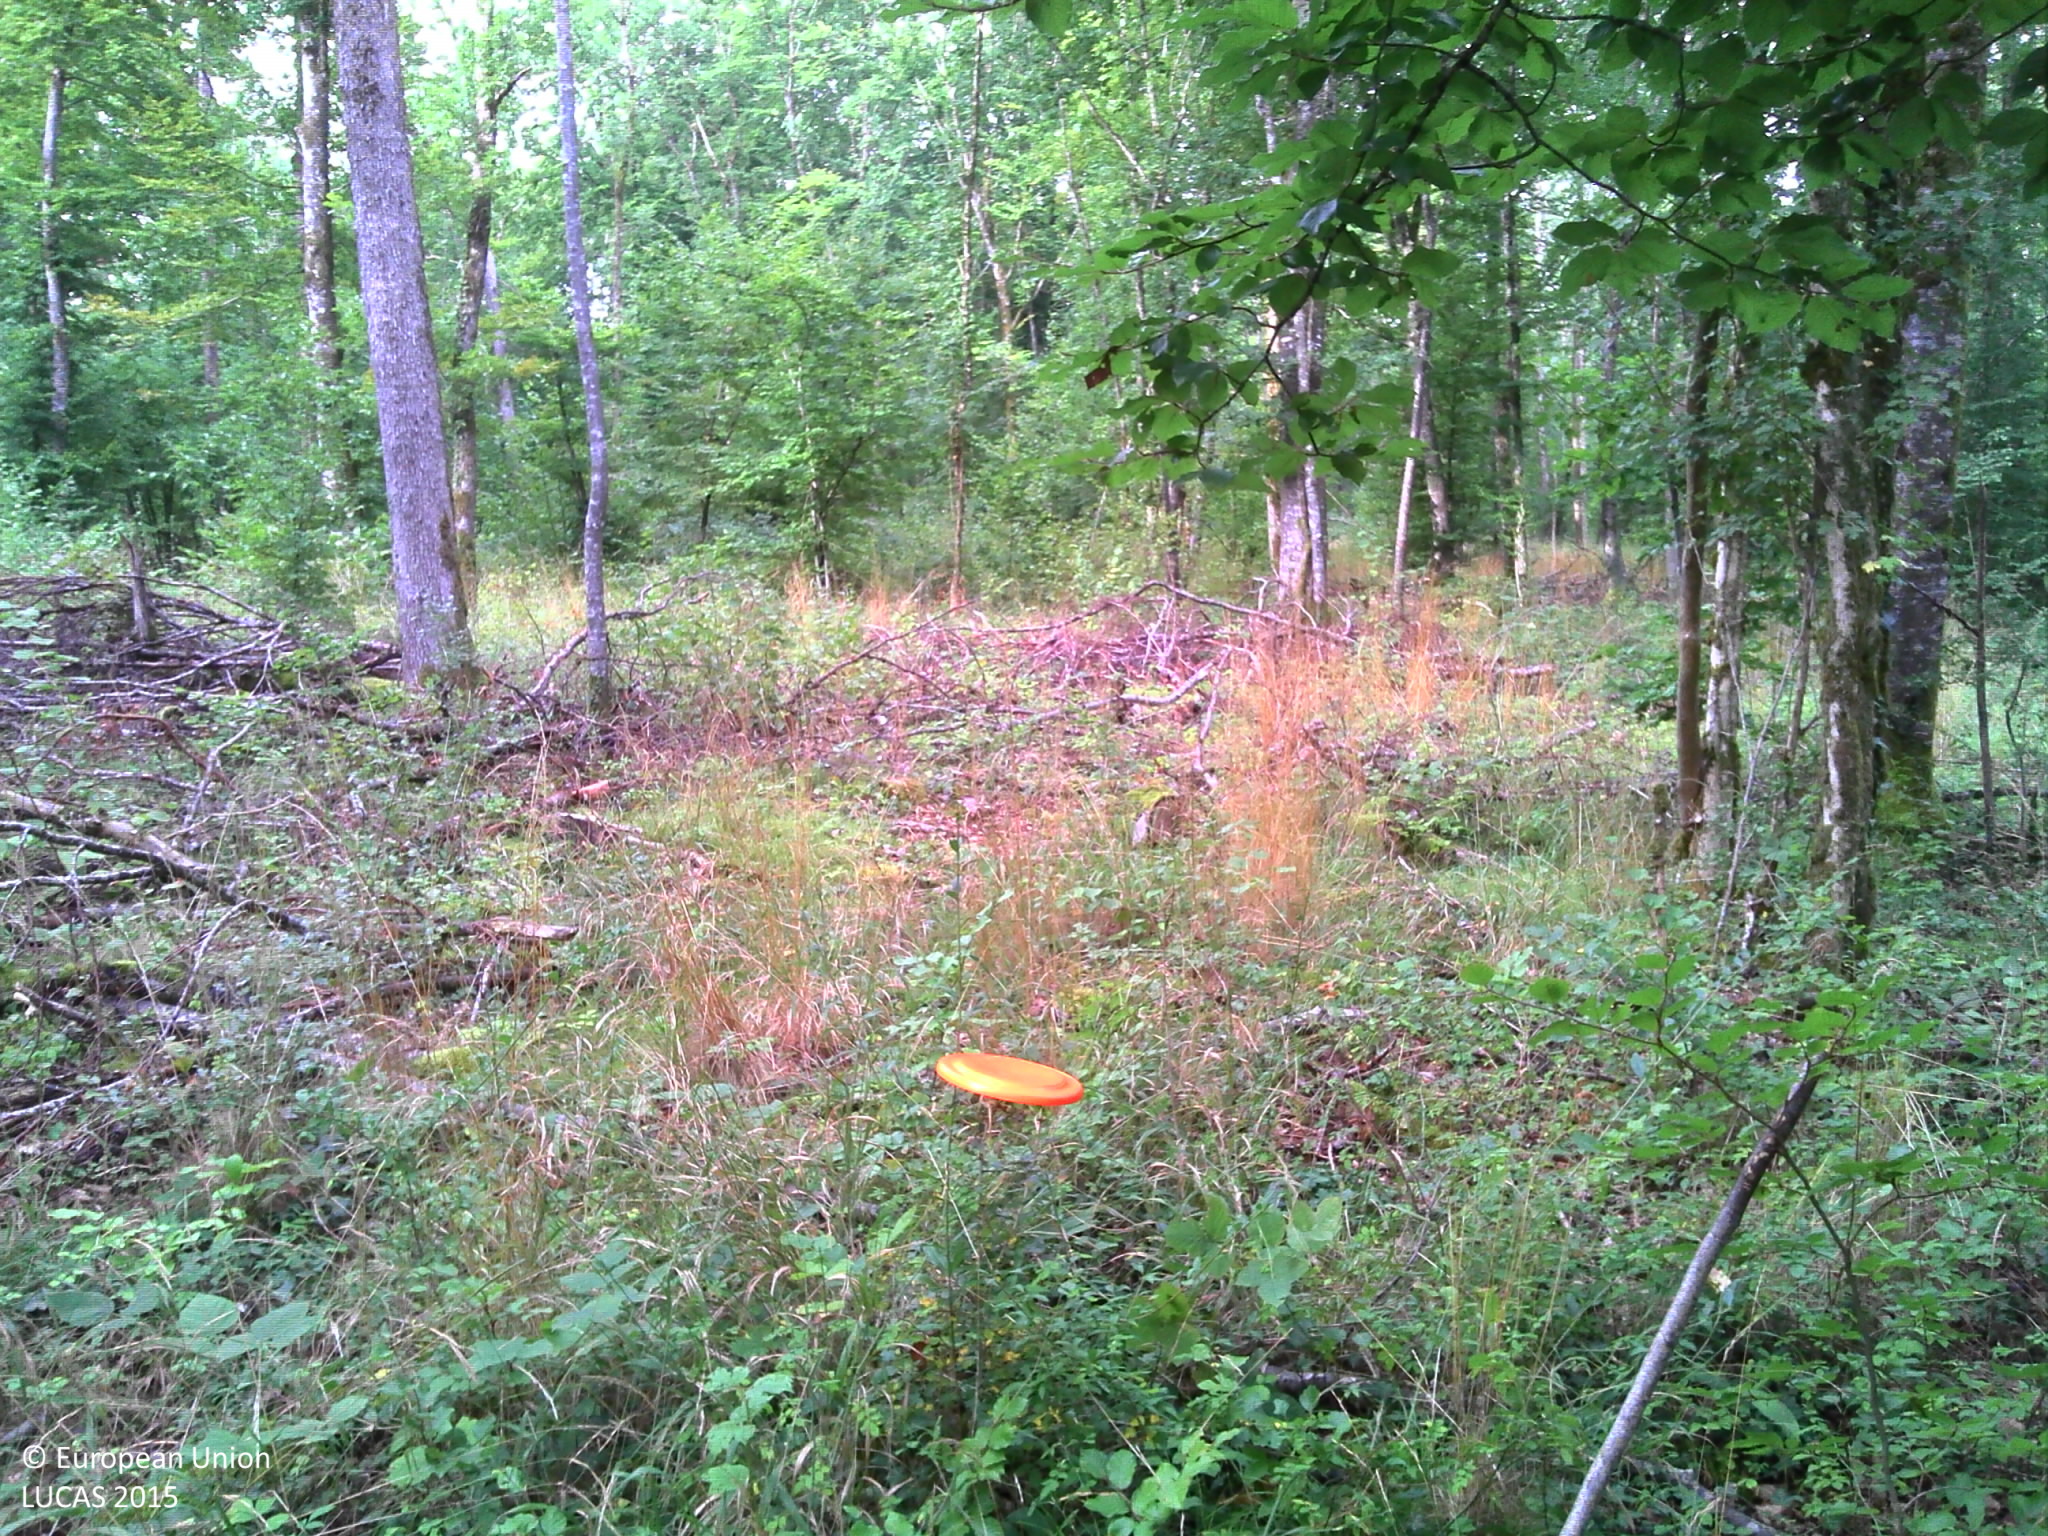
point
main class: Woodland
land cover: Broadleaved woodland
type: mesophytic deciduous forest
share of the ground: > 75 %
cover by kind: broadleaved forest trees 90 %, herbaceous plants 5 %, lichens and mosses 5 %
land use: Forestry
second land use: Amenities, museums, leisure
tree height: > 5 m
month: September
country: FR
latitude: 47.6343
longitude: 4.8489
